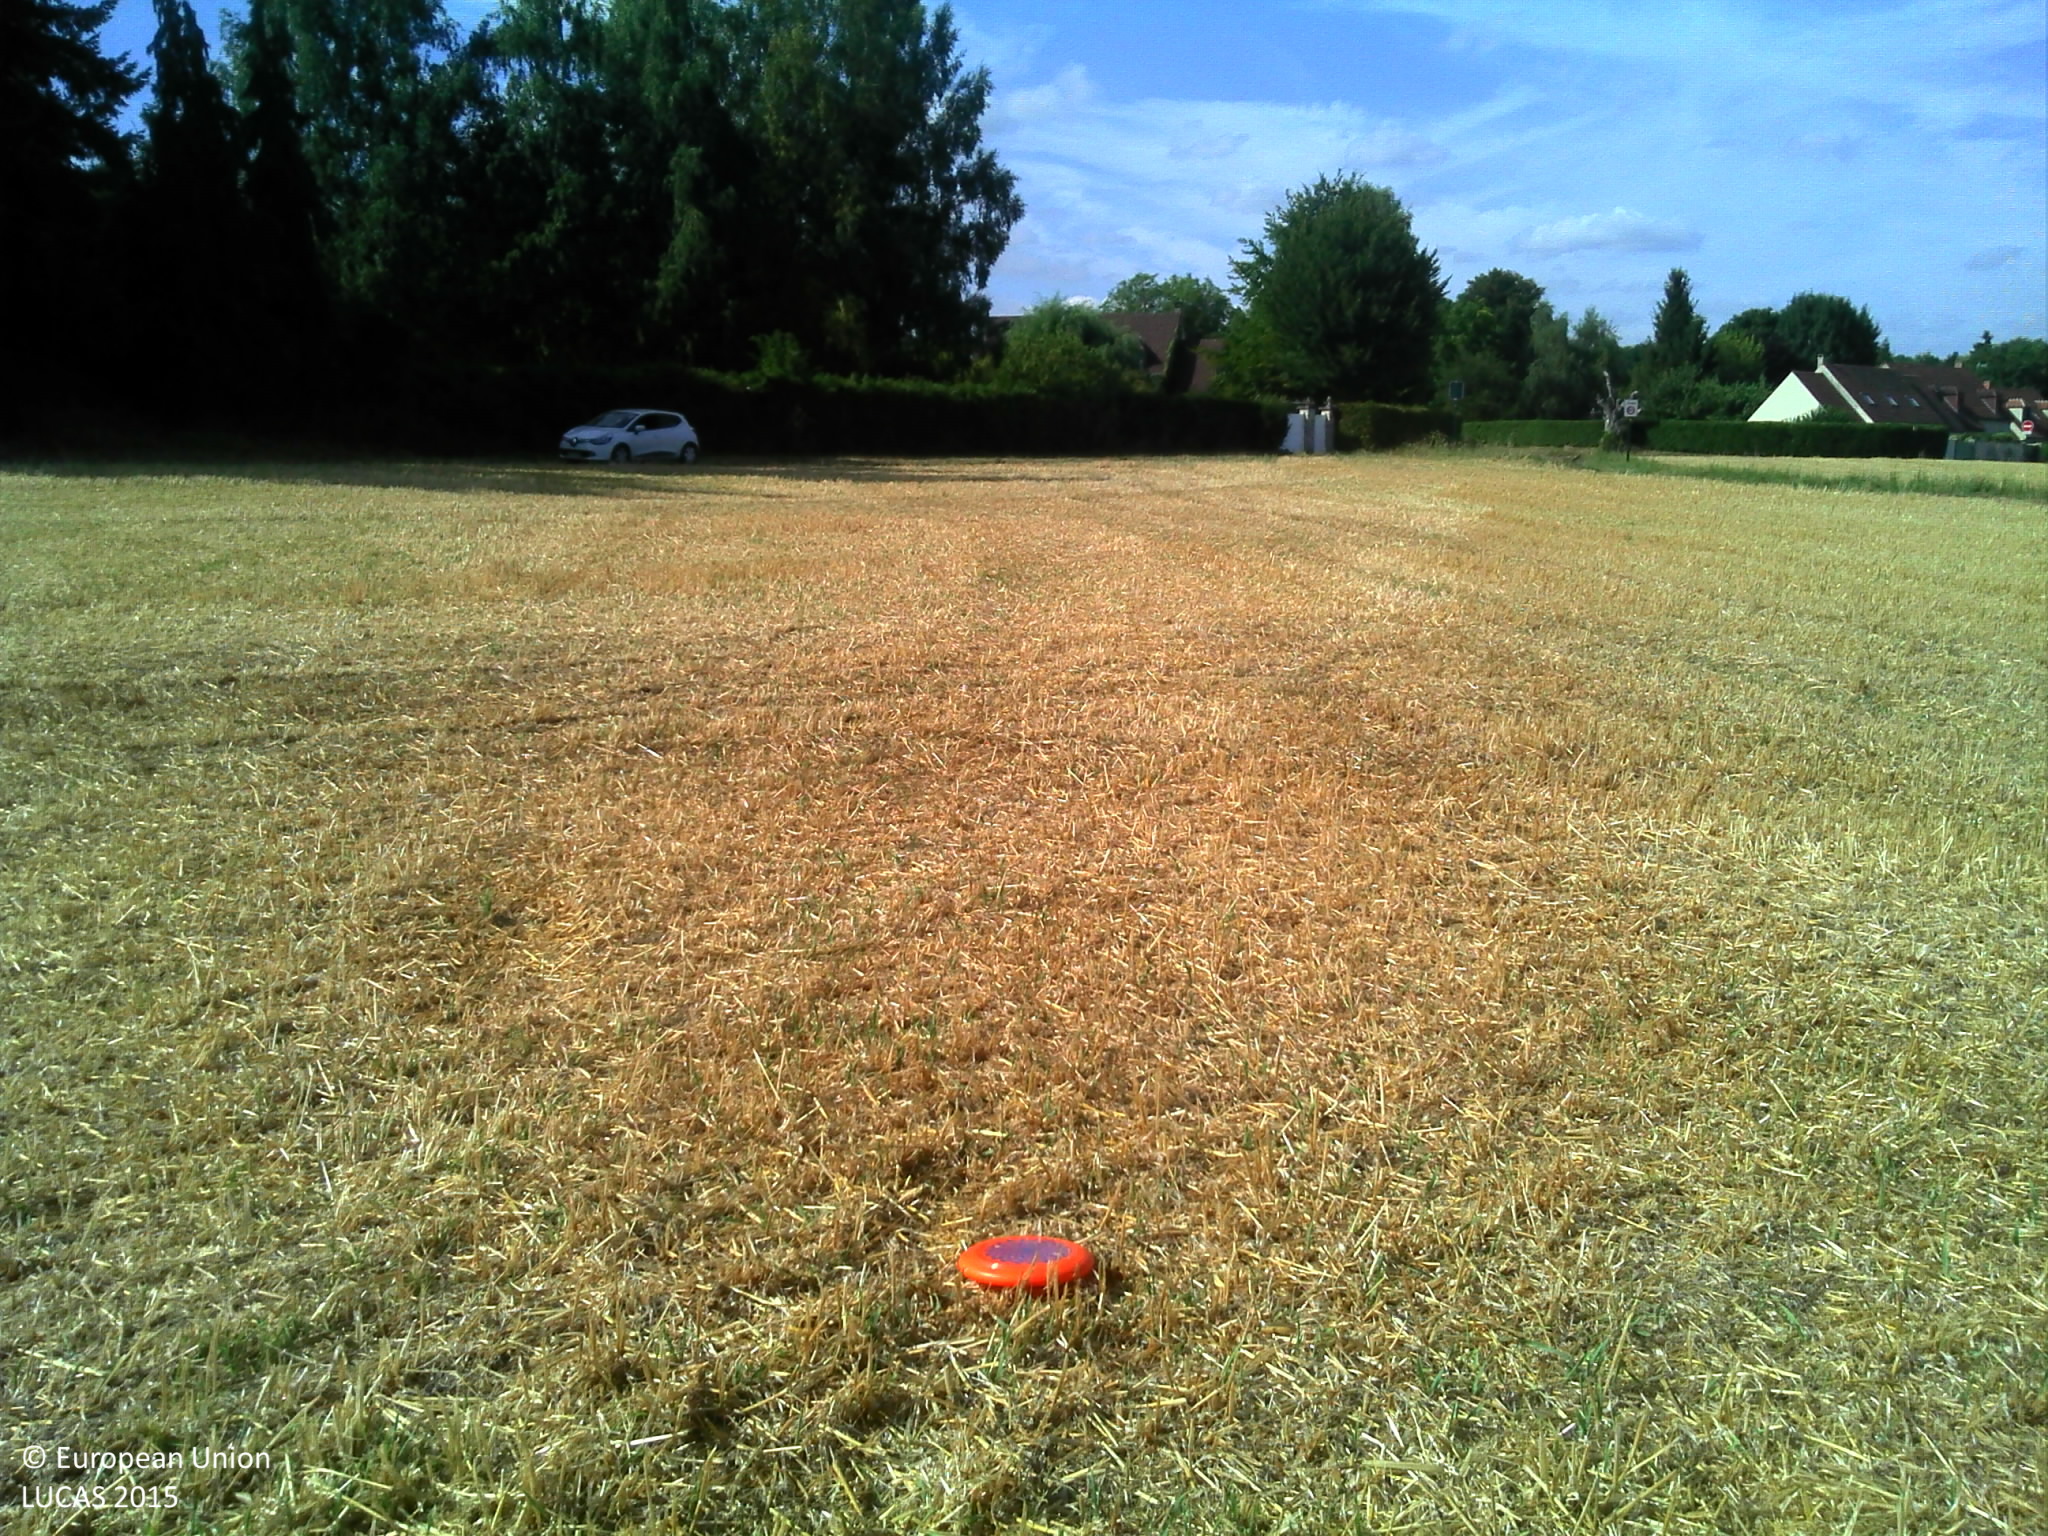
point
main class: Cropland
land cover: Common wheat
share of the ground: > 75 %
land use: Agriculture (excluding fallow land and kitchen gardens)
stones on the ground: < 10 %
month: August
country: FR
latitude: 49.0620
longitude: 1.8689
